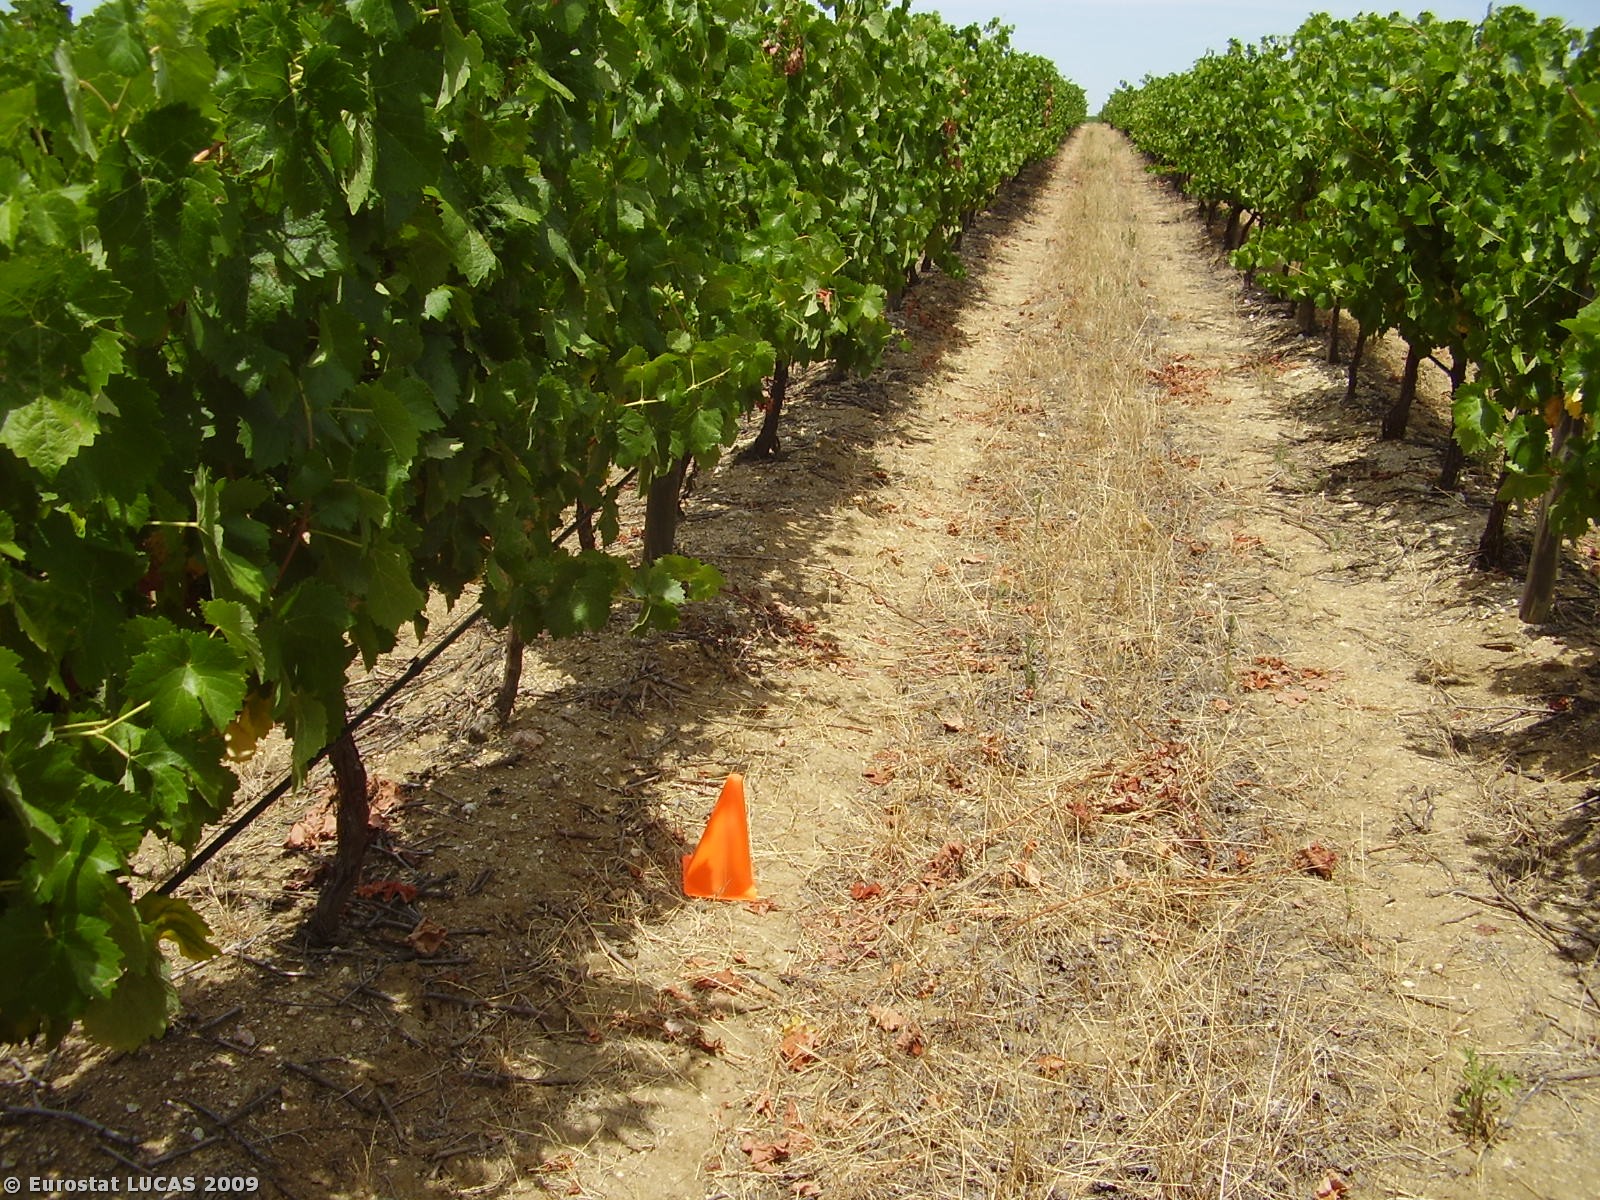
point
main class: Cropland
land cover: Vineyards
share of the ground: 10 - 25 %
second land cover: Spontaneously vegetated surfaces
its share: 50 - 75 %
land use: Agriculture (excluding fallow land and kitchen gardens)
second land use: Fallow land
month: July
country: PT
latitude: 38.5447
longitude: -7.8325
